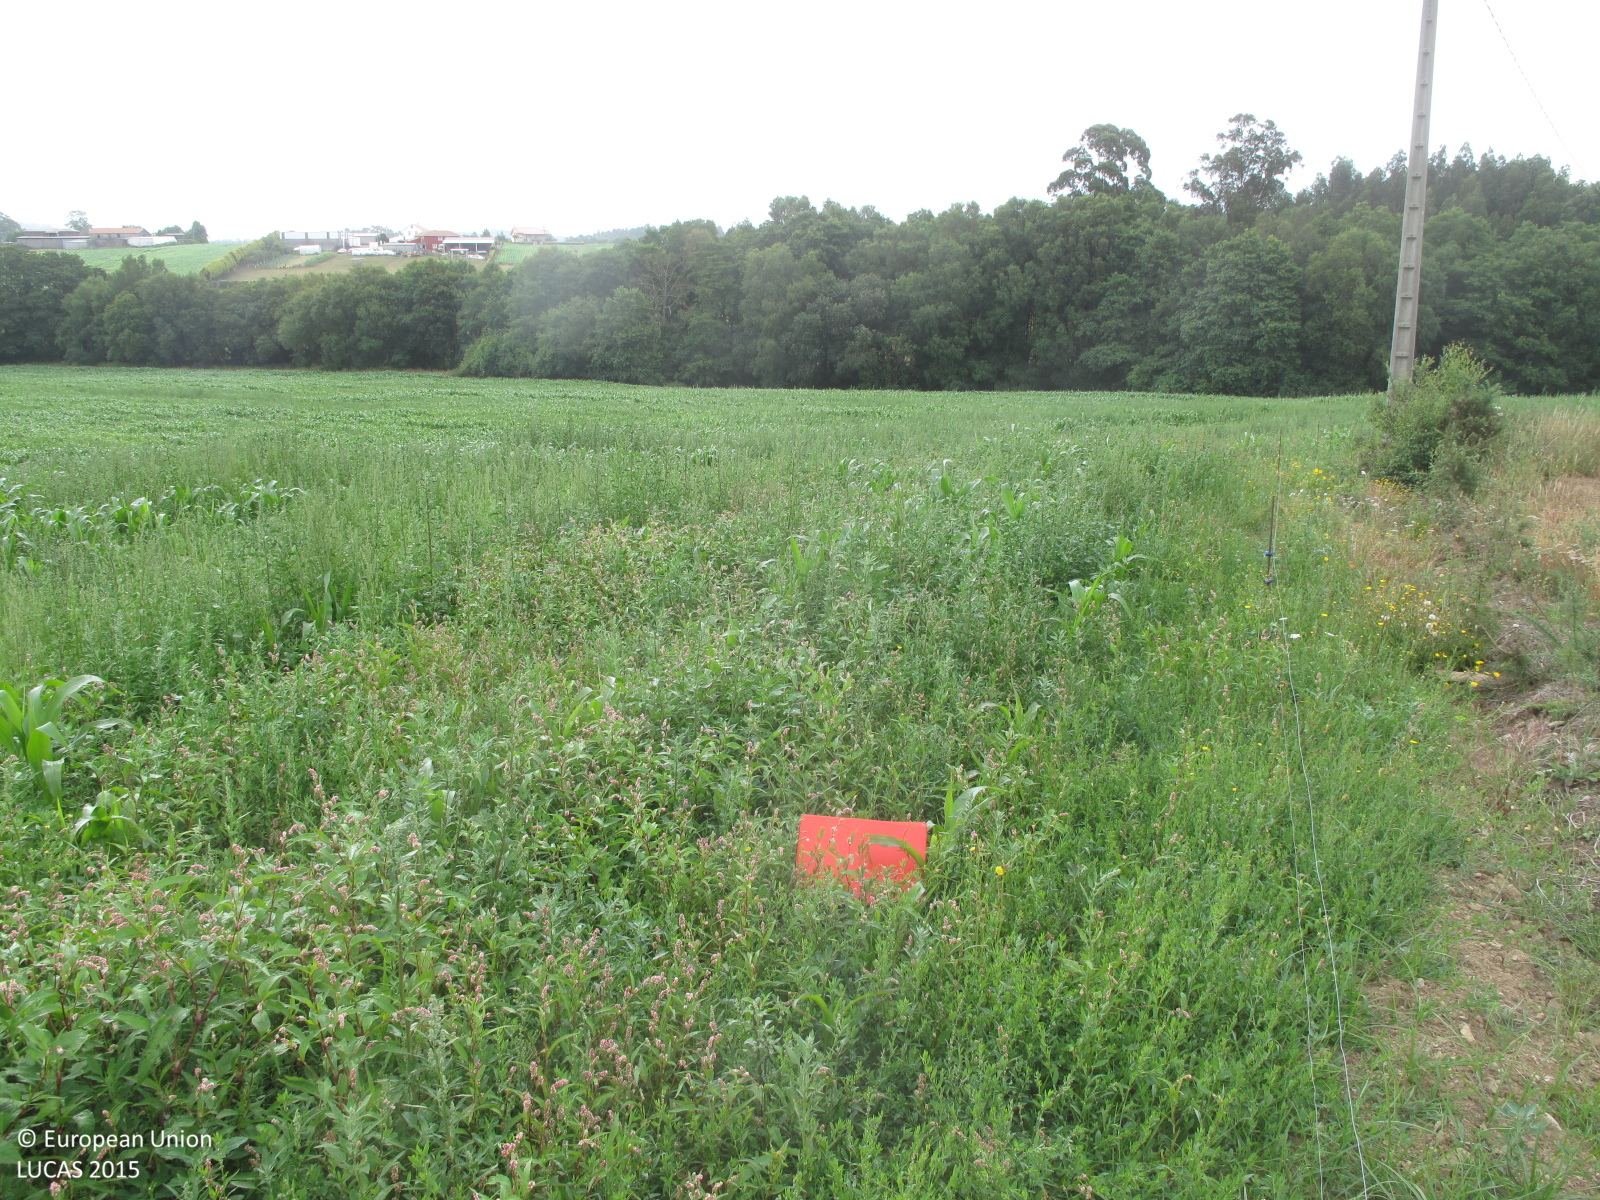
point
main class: Cropland
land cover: Maize
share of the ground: 25 - 50 %
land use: Agriculture (excluding fallow land and kitchen gardens)
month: July
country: ES
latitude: 43.5742
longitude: -8.0918
